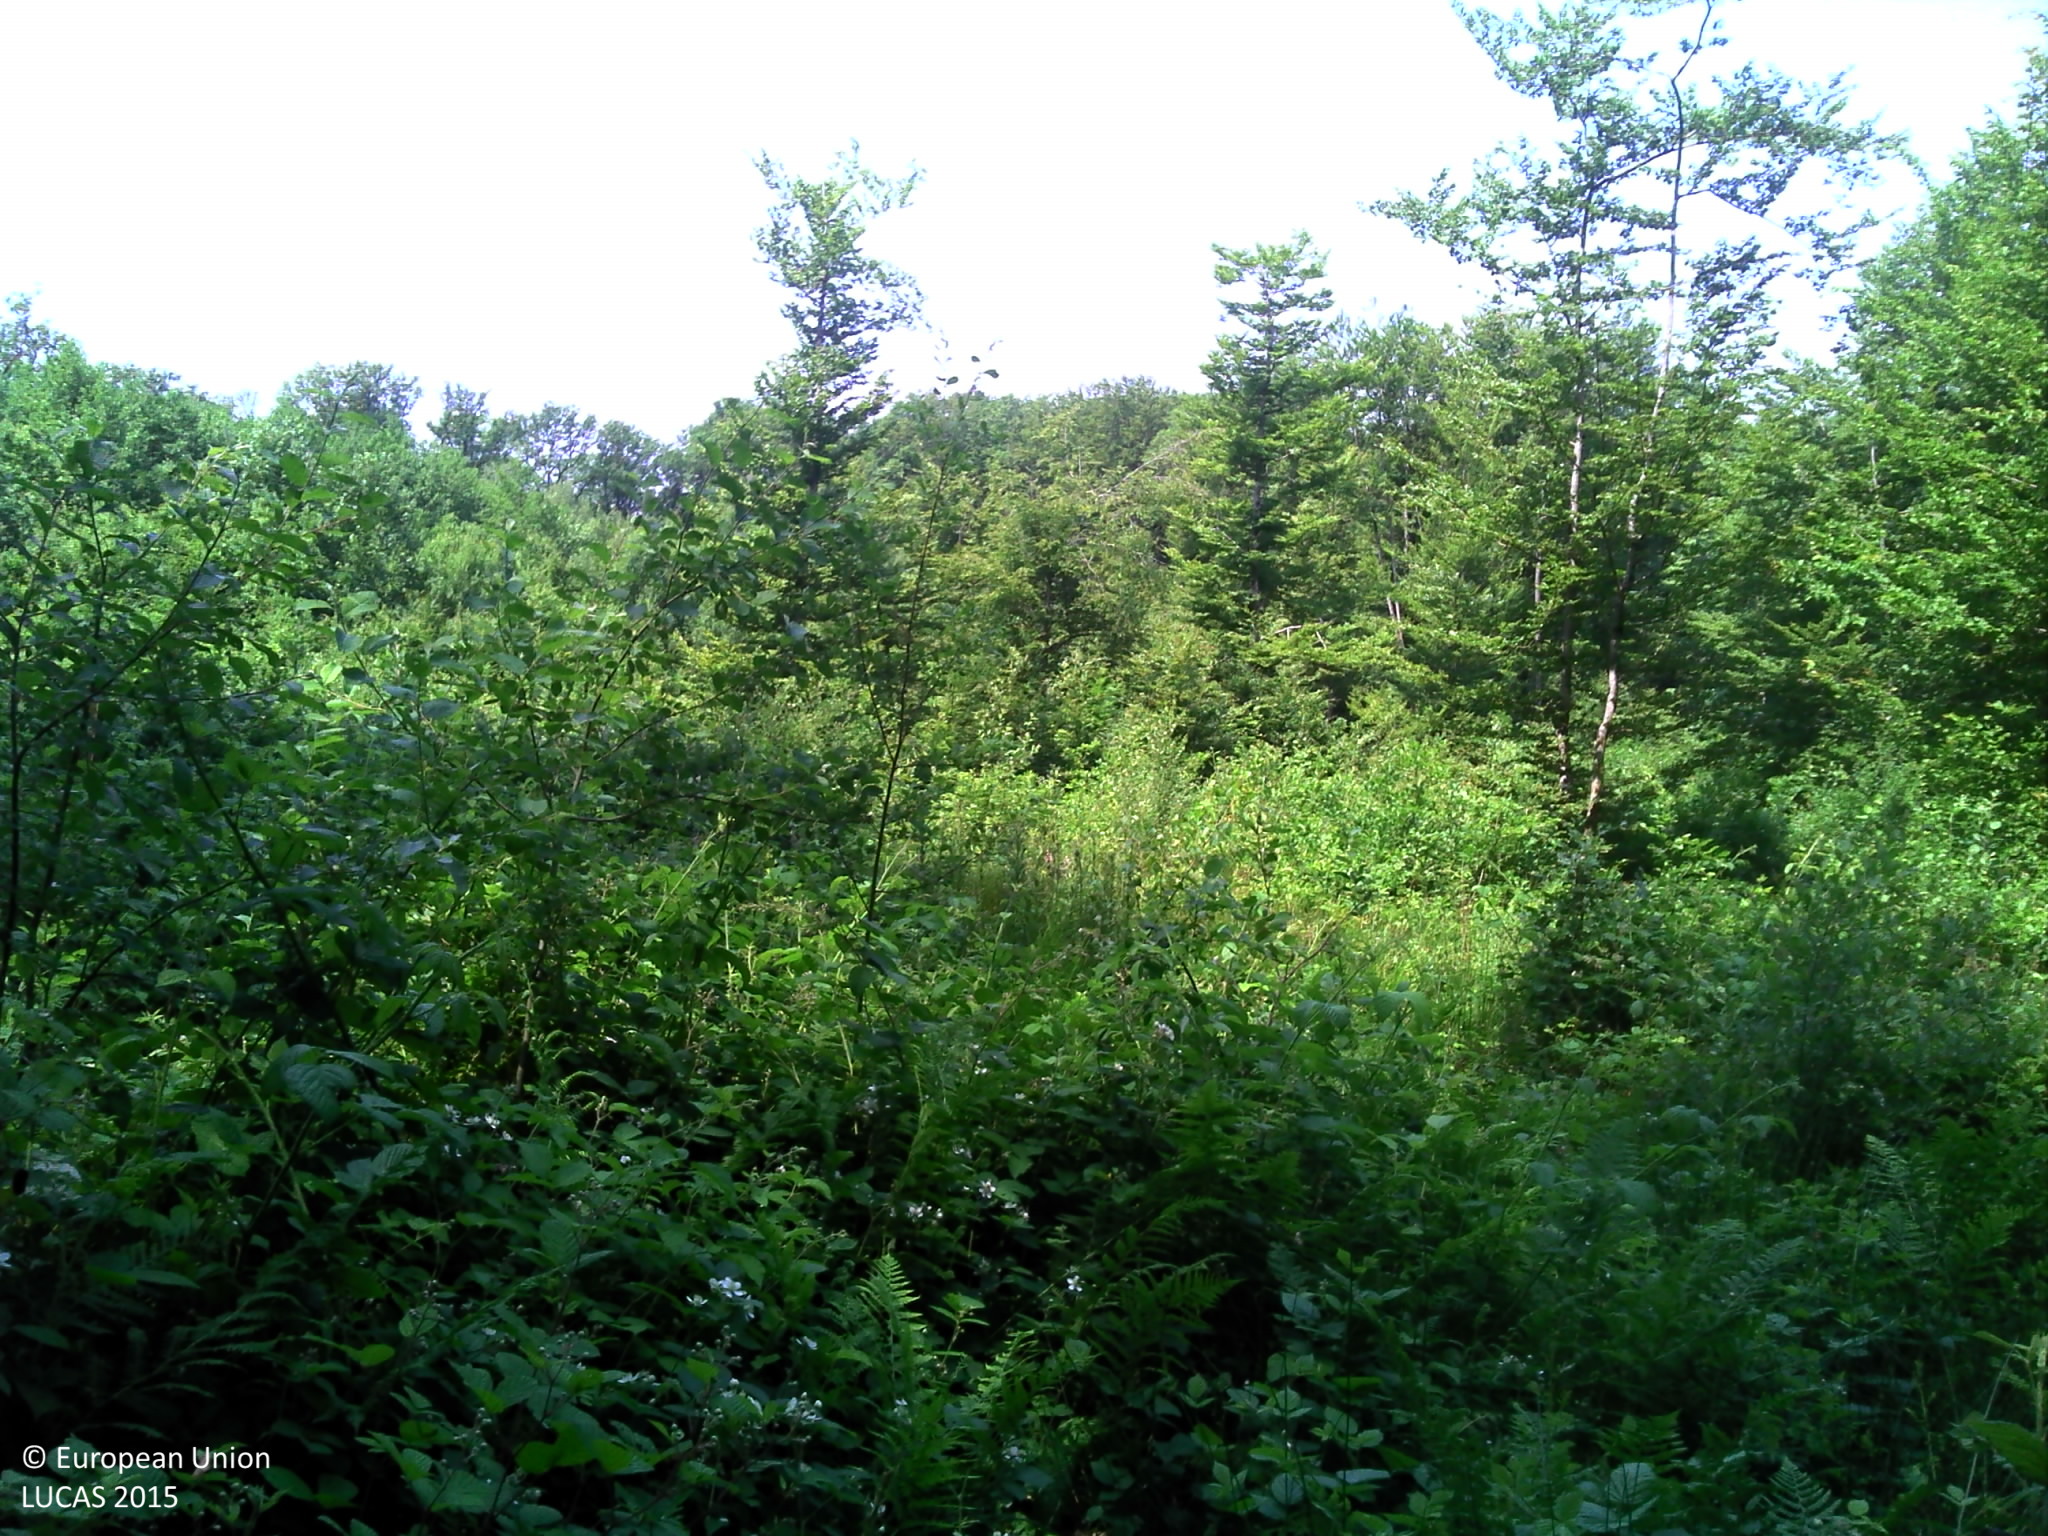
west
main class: Shrubland
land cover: Shrubland without tree cover
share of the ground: > 75 %
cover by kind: shrubs 95 %, herbaceous plants 5 %
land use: Forestry
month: June
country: FR
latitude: 47.8543
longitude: 6.2721
